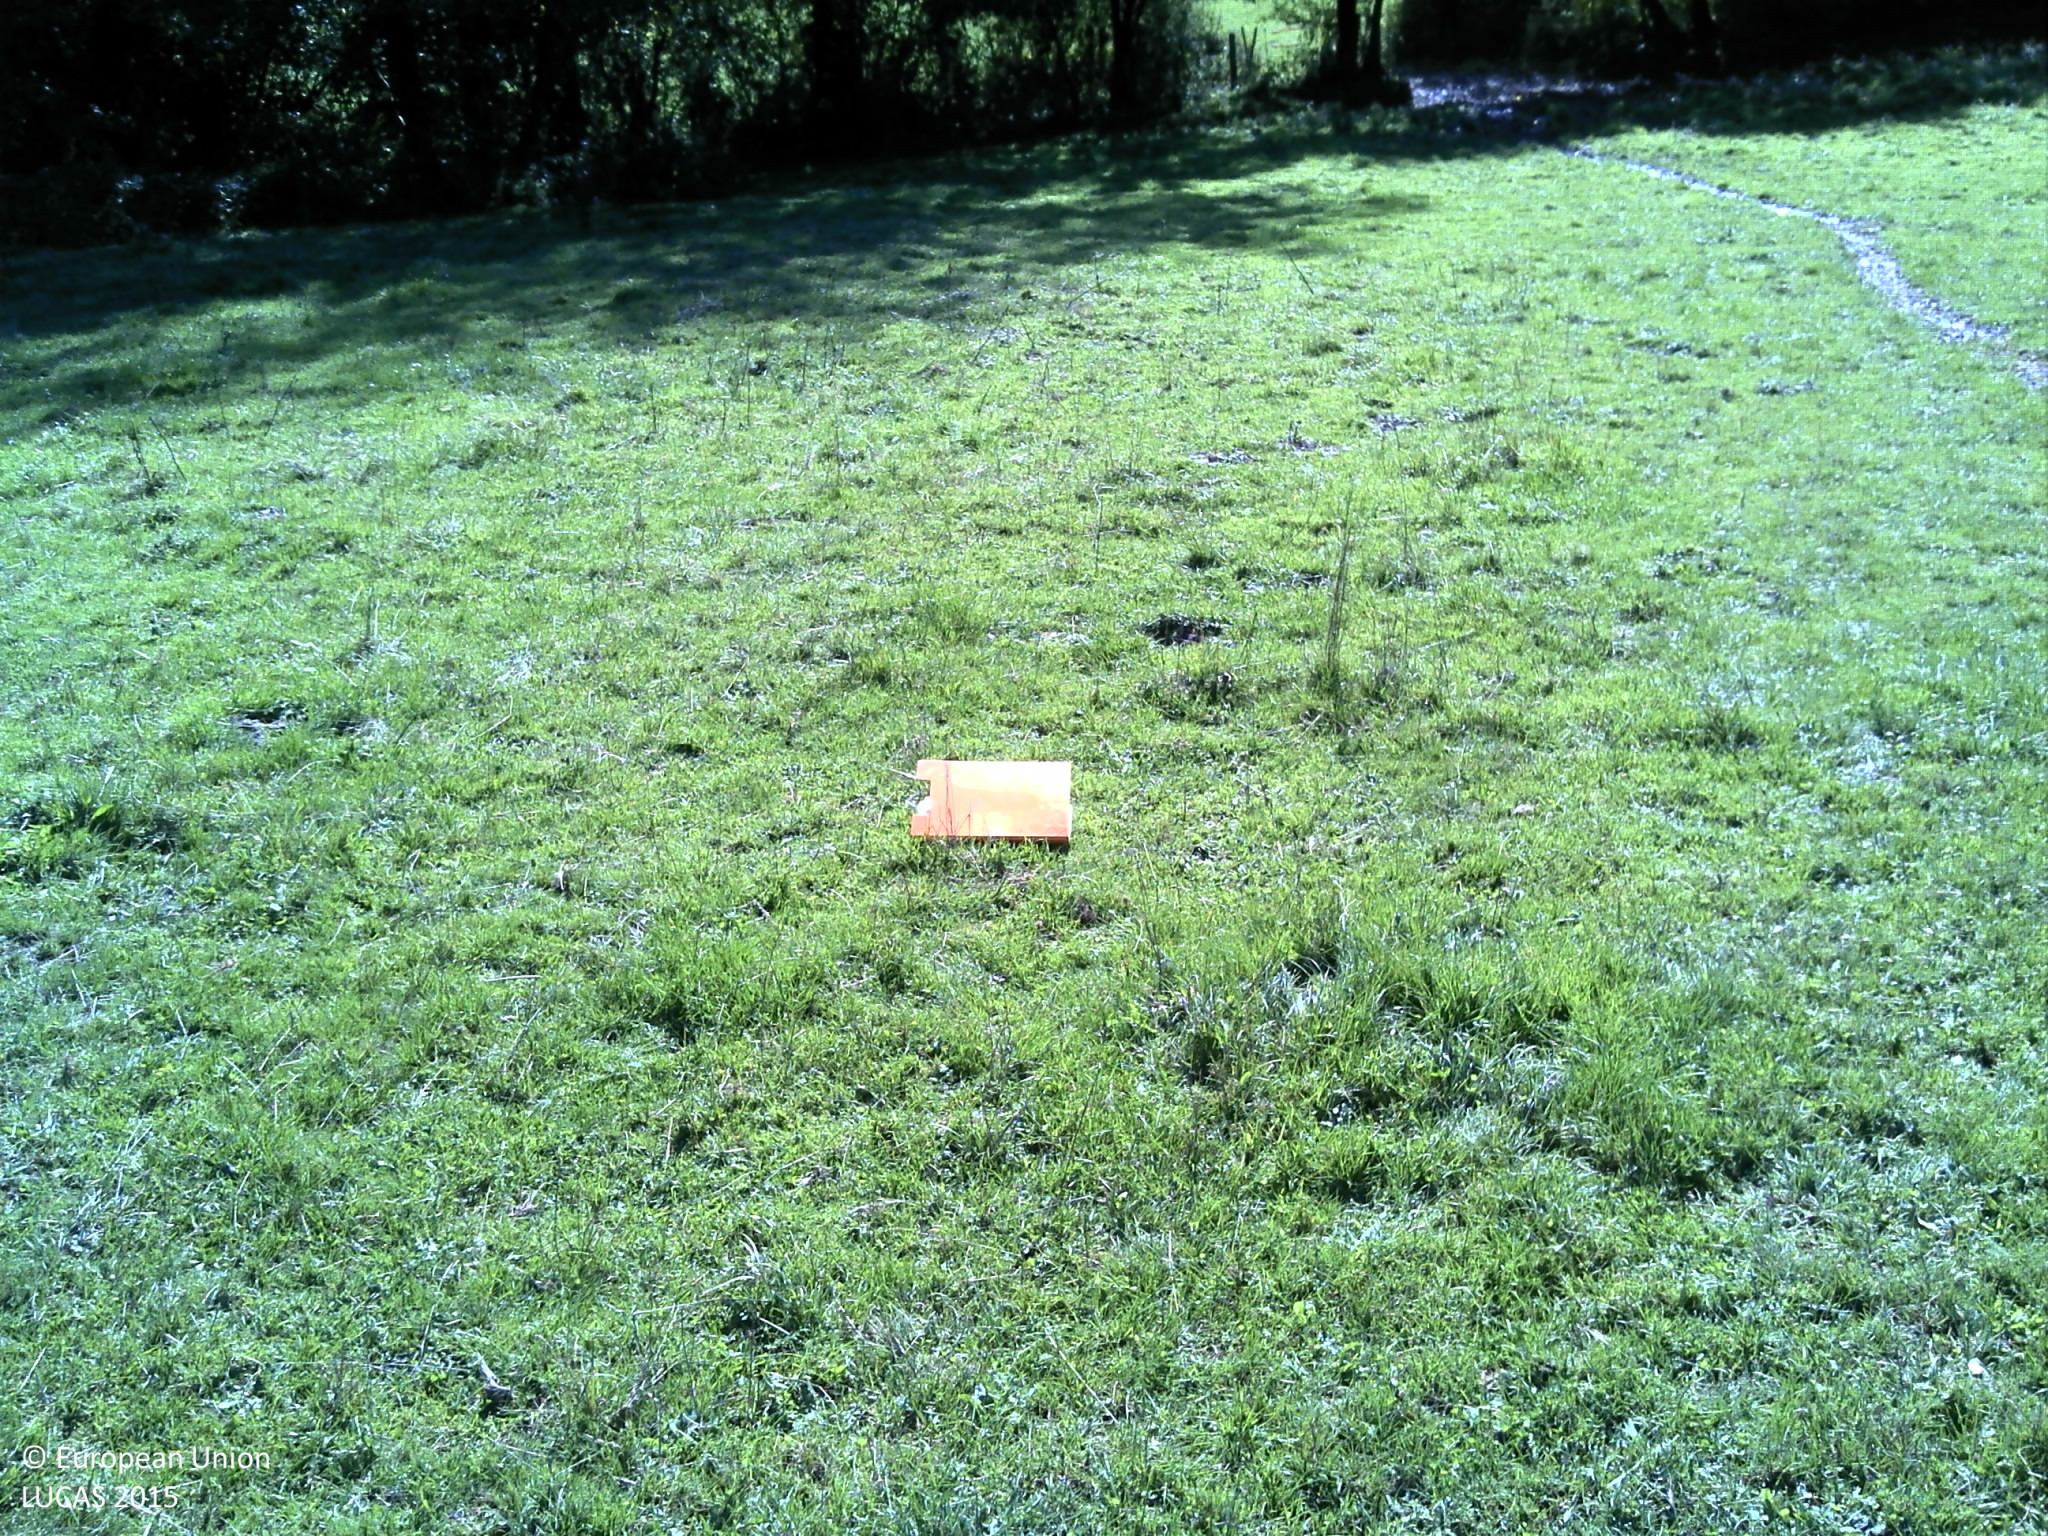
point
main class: Grassland
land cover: Grassland without tree/shrub cover
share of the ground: > 75 %
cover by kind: herbaceous plants 100 %
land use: Agriculture (excluding fallow land and kitchen gardens)
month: October
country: FR
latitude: 46.6000
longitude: 4.0343
